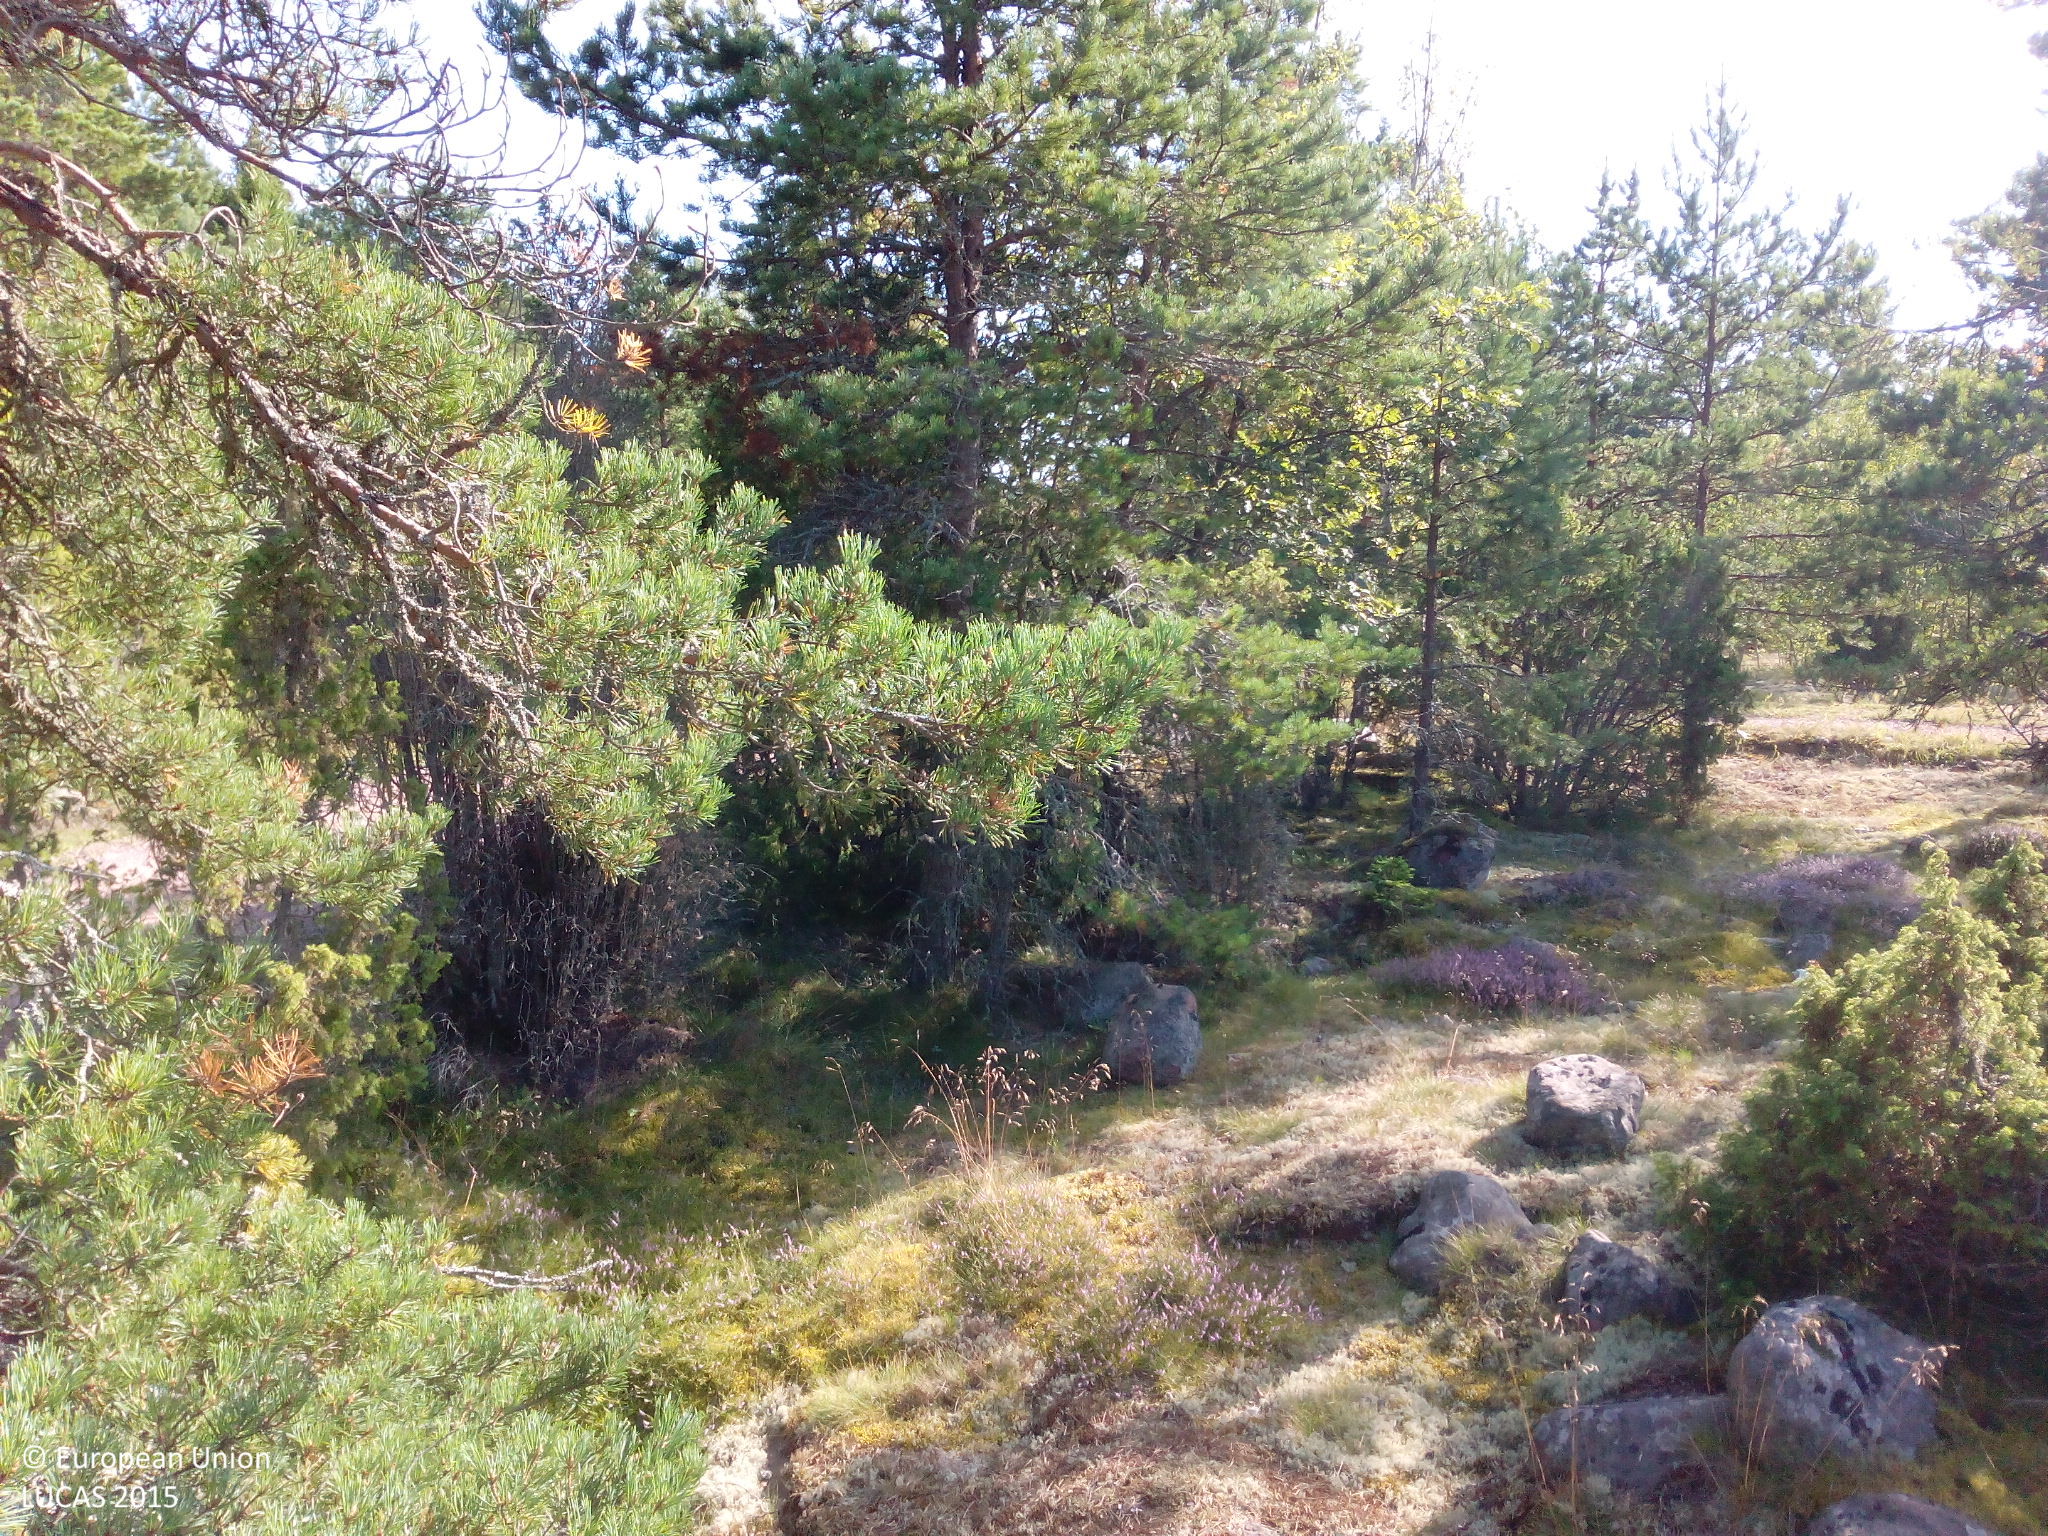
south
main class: Woodland
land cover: Pine dominated coniferous woodland
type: hemiboreal forest and nemoral coniferous forest and mixed broadleaved-coniferous forest
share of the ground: 50 - 75 %
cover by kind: coniferous forest trees 60 %, lichens and mosses 20 %, broadleaved forest trees 10 %, unconsolidated bare surface 10 %
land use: Semi-natural and natural areas not in use
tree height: > 5 m
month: August
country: FI
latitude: 60.2627
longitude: 19.7096
